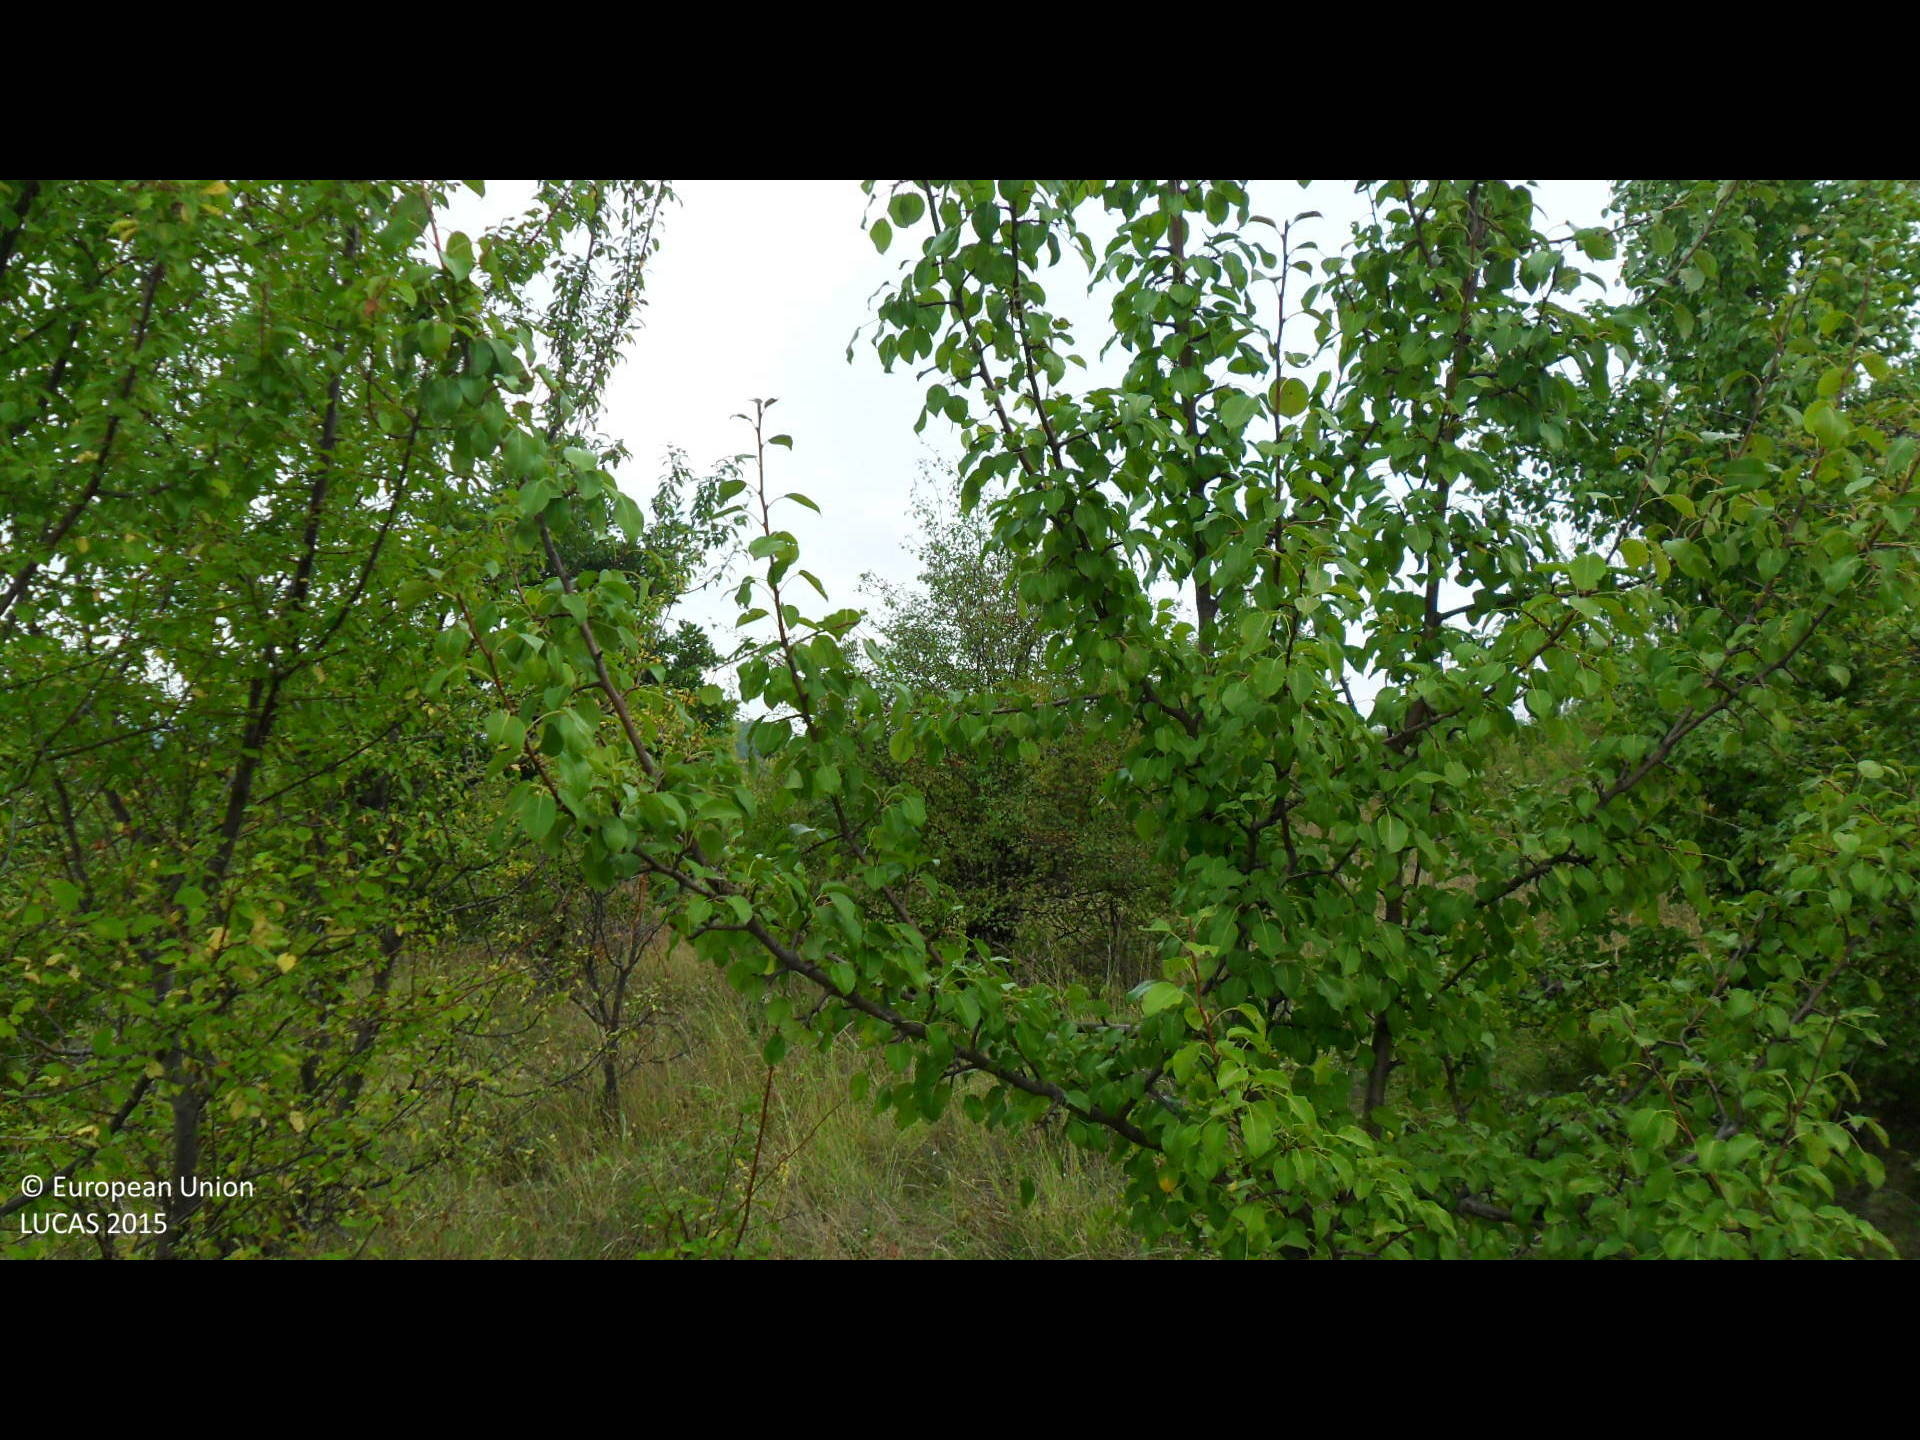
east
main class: Grassland
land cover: Grassland with sparse tree/shrub cover
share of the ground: > 75 %
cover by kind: herbaceous plants 90 %, broadleaved forest trees 5 %, shrubs 5 %
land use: Semi-natural and natural areas not in use
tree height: < 5 m
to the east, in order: Grassland with sparse tree/shrub cover; Broadleaved woodland
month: September
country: BG
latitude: 43.2676
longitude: 26.0964
